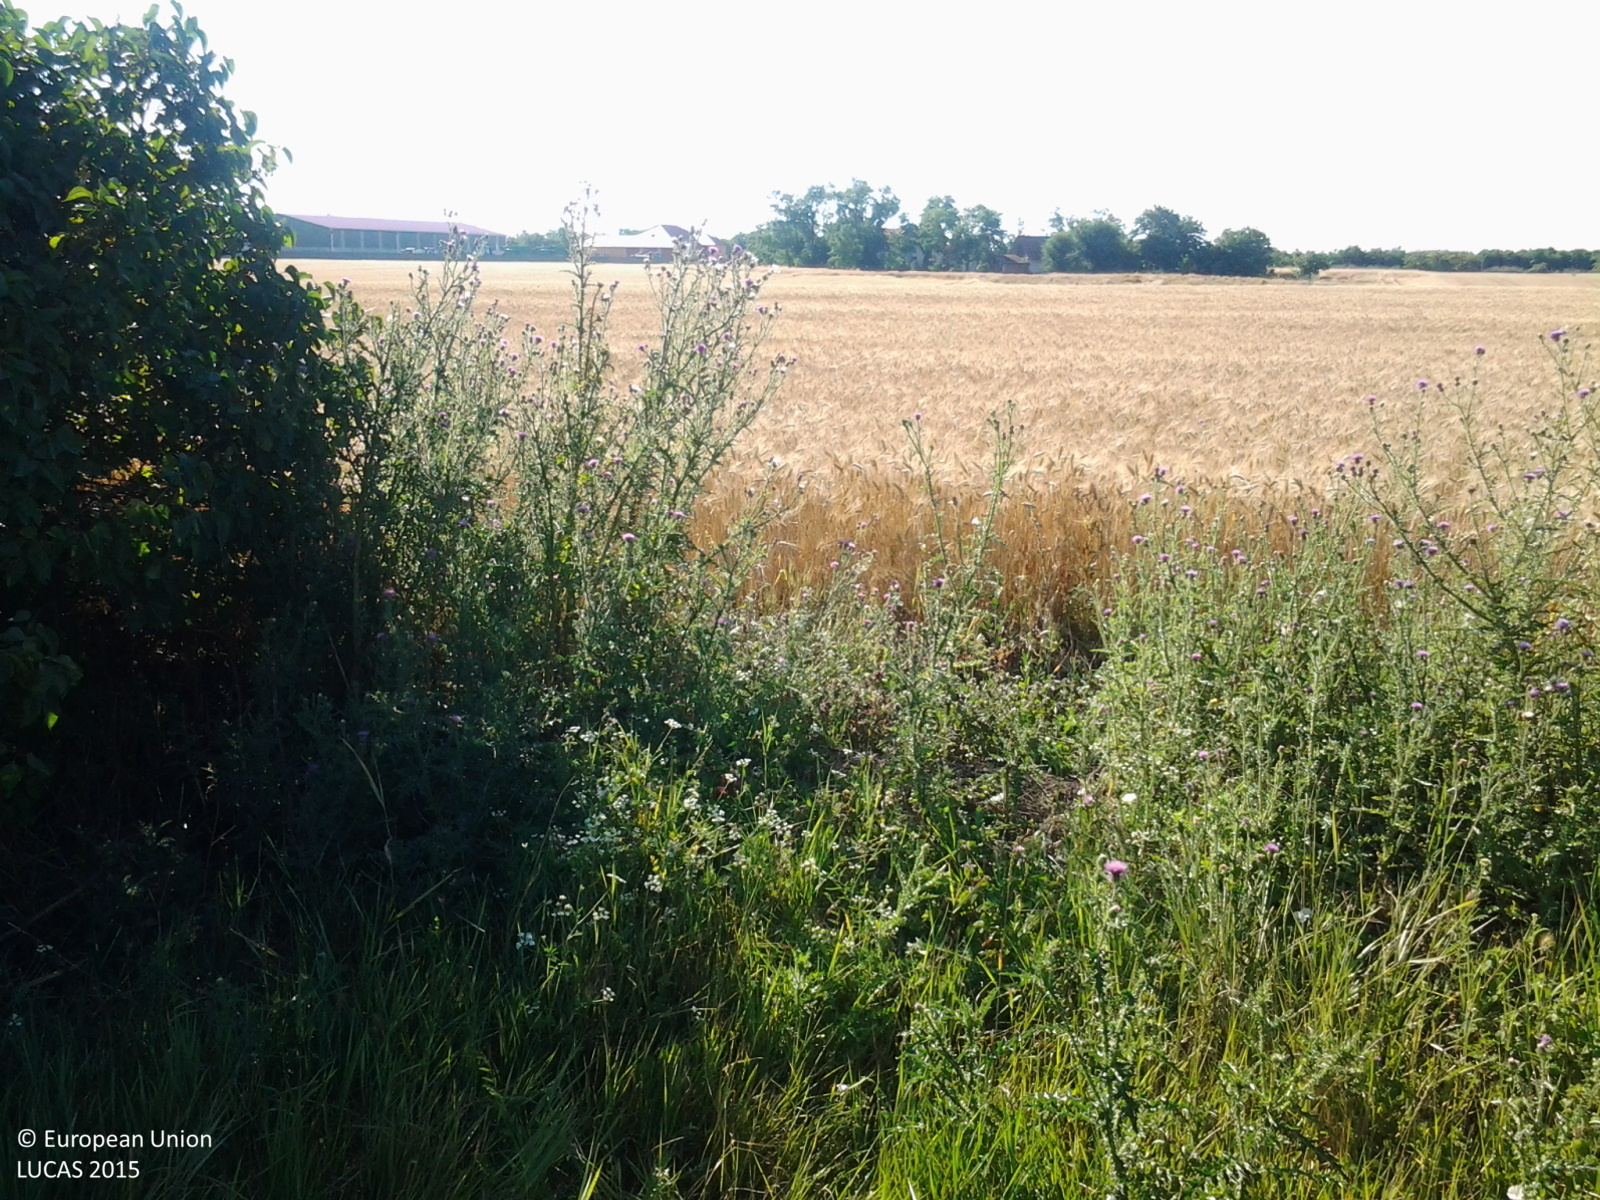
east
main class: Woodland
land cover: Broadleaved woodland
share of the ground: 10 - 25 %
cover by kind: herbaceous plants 75 %, broadleaved forest trees 15 %, shrubs 10 %
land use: Forestry
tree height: > 5 m
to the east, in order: Broadleaved woodland; Common wheat
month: July
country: HU
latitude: 47.0702
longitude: 20.4714
